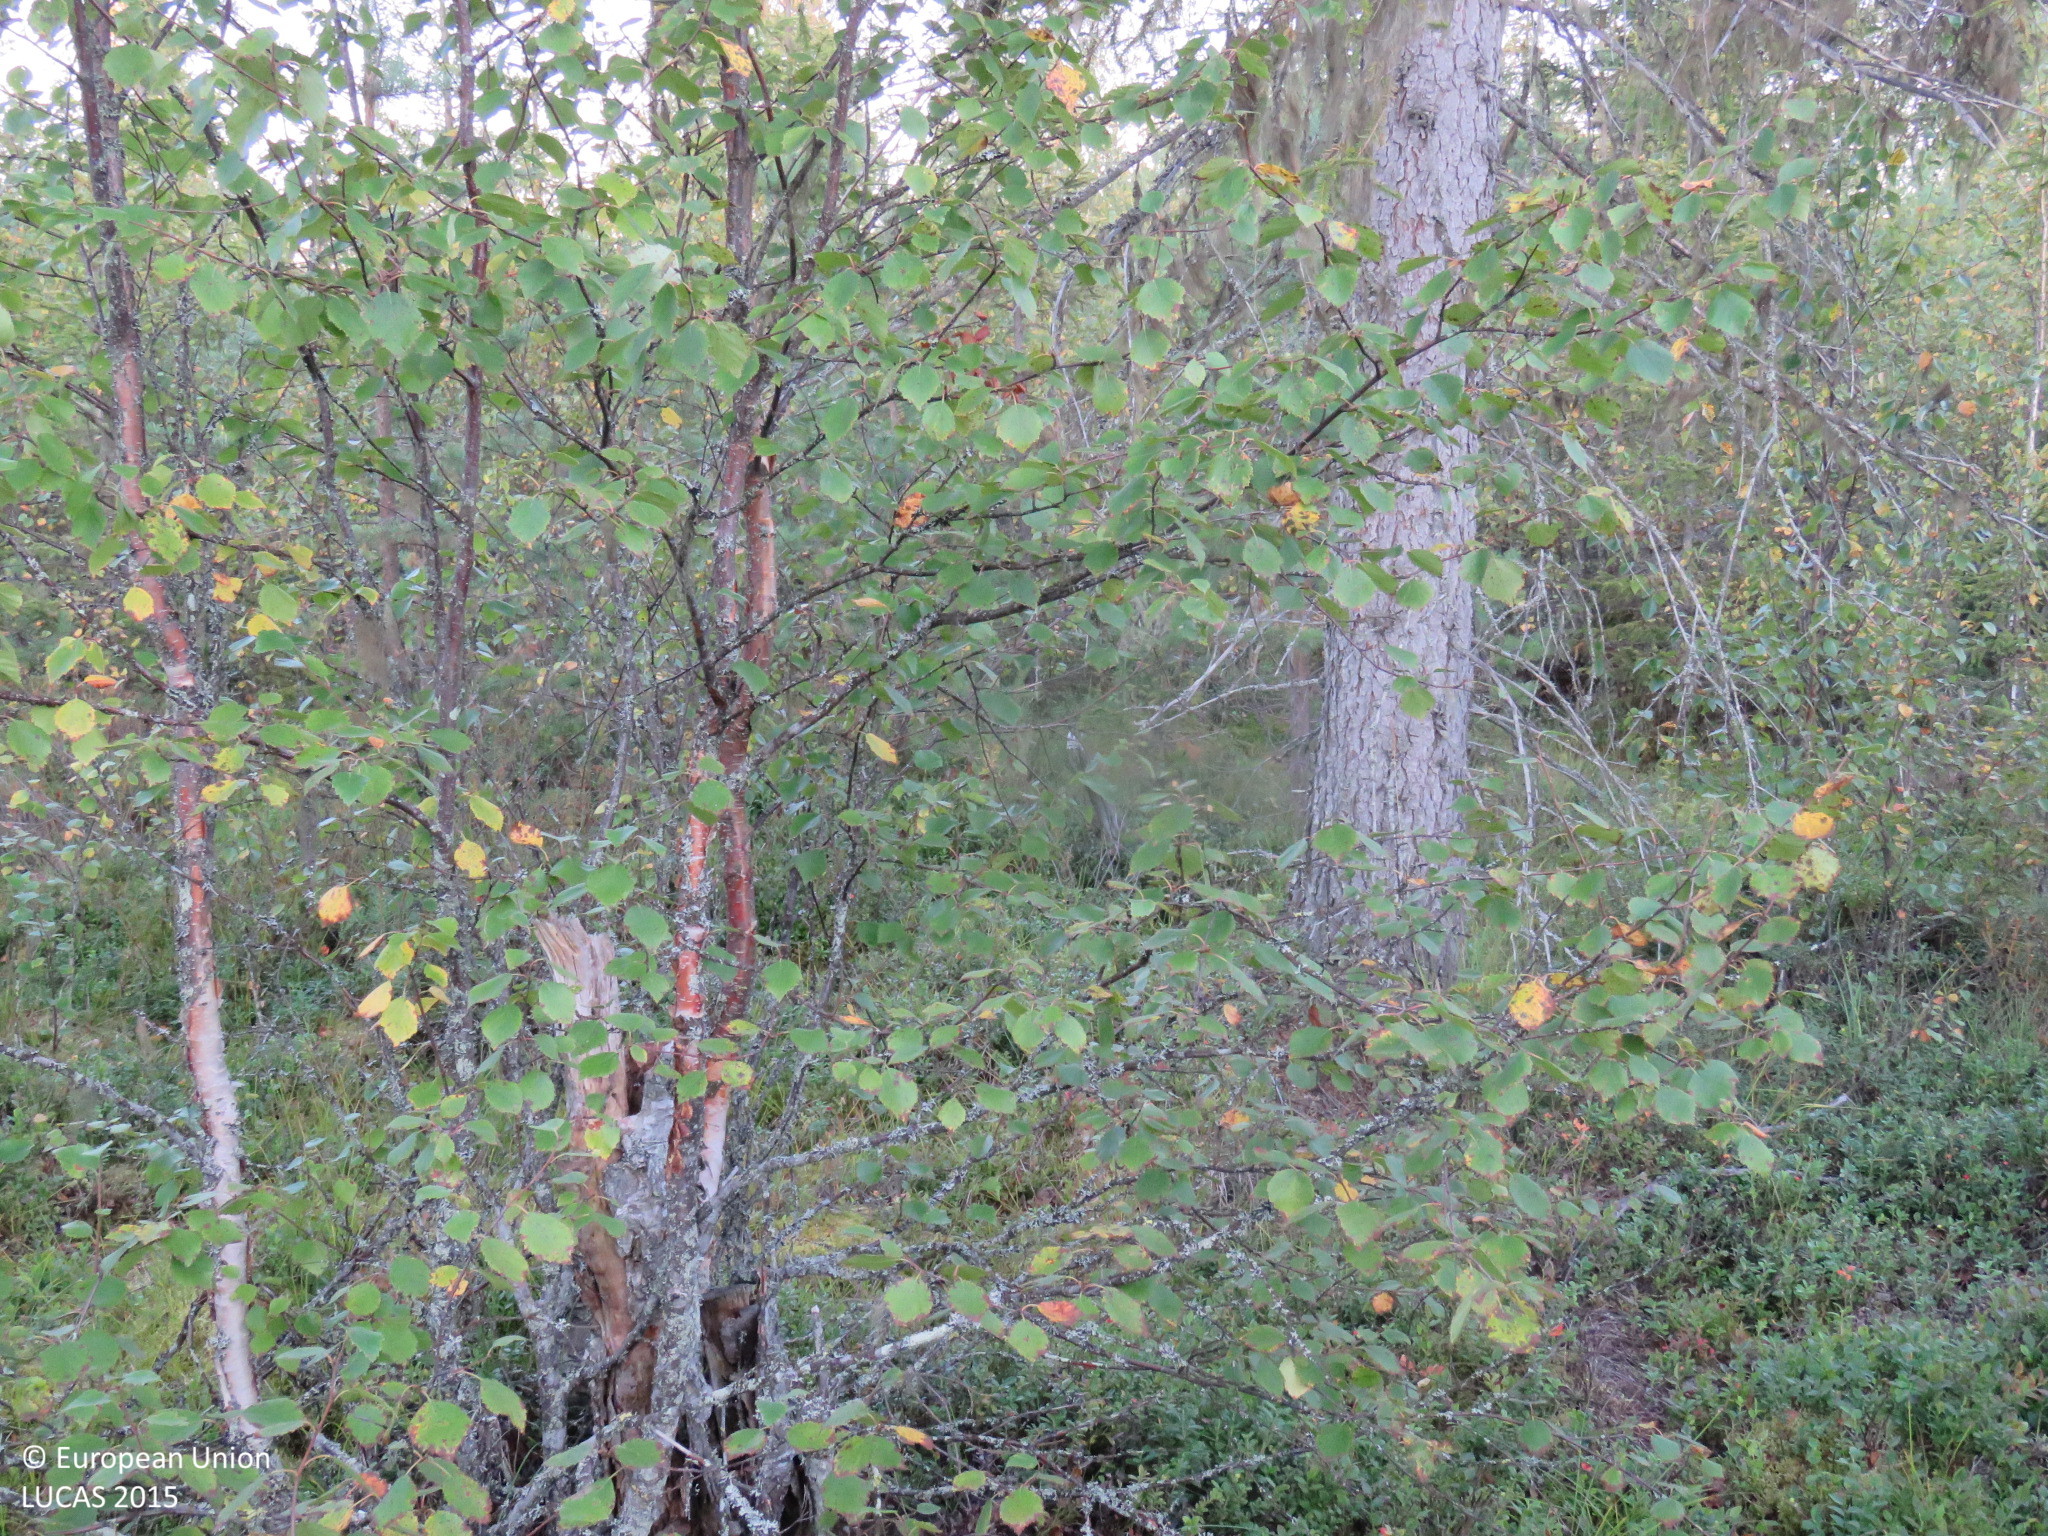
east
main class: Woodland
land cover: Other mixed woodland
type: boreal forest
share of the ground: > 75 %
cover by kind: coniferous forest trees 60 %, broadleaved forest trees 30 %, shrubs 10 %
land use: Forestry
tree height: > 5 m
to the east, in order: Other mixed woodland; Ditches and canals; Other mixed woodland; Ditches and canals; Other mixed woodland; Ditches and canals; Other mixed woodland; Ditches and canals; Other mixed woodland
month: August
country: FI
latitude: 65.3352
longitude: 26.4014
